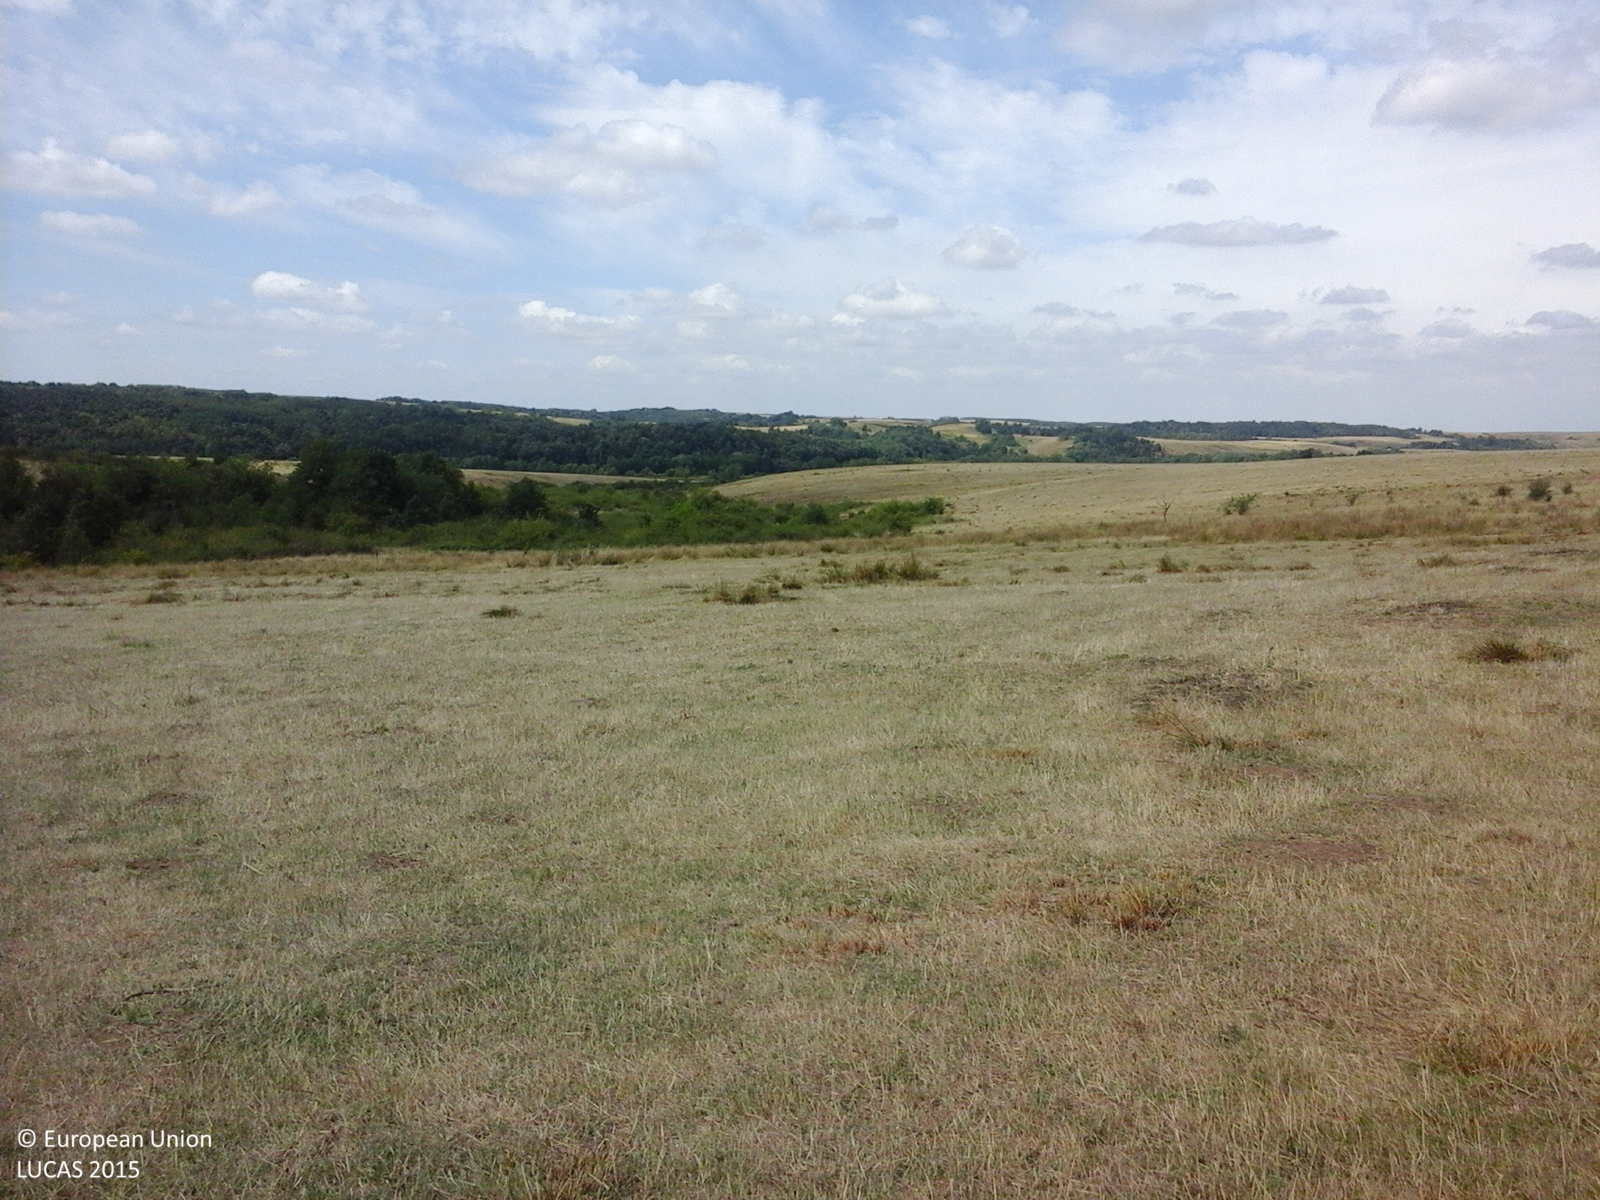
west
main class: Grassland
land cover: Grassland without tree/shrub cover
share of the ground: > 75 %
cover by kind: herbaceous plants 100 %
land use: Agriculture (excluding fallow land and kitchen gardens)
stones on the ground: < 10 %
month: August
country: RO
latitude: 45.3266
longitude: 21.6820
